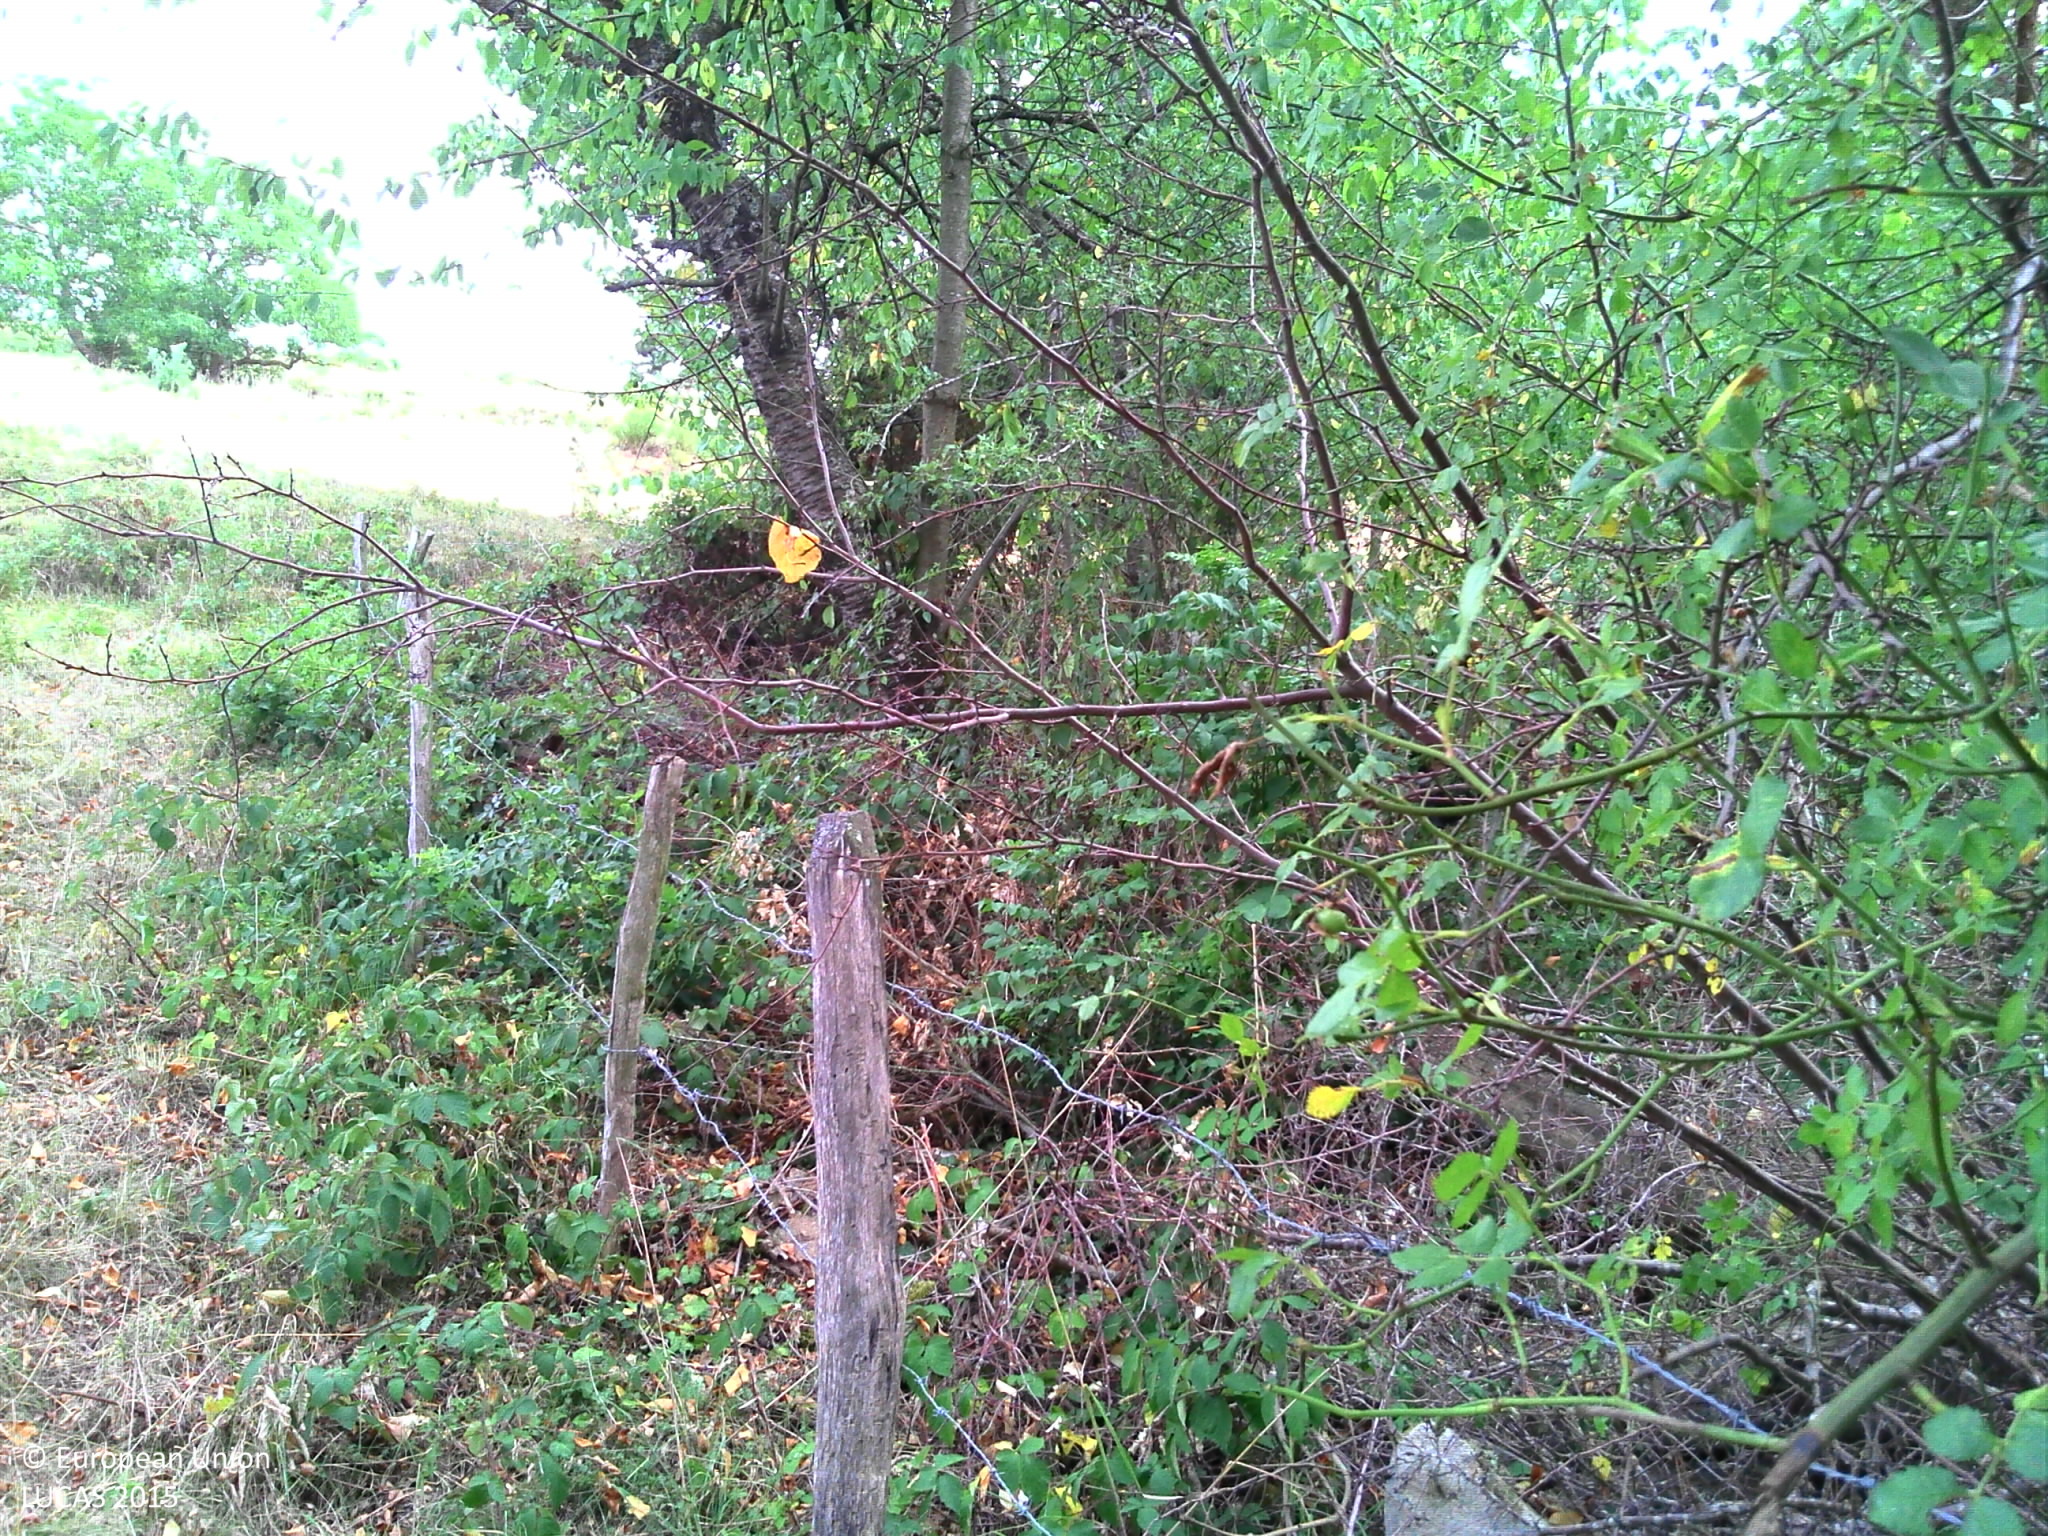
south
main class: Woodland
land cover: Broadleaved woodland
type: acidophilous oak and oak-birch forest
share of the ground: > 75 %
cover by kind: broadleaved forest trees 75 %, herbaceous plants 15 %, shrubs 10 %
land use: Forestry
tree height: > 5 m
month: July
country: FR
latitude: 45.1353
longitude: 3.4033
